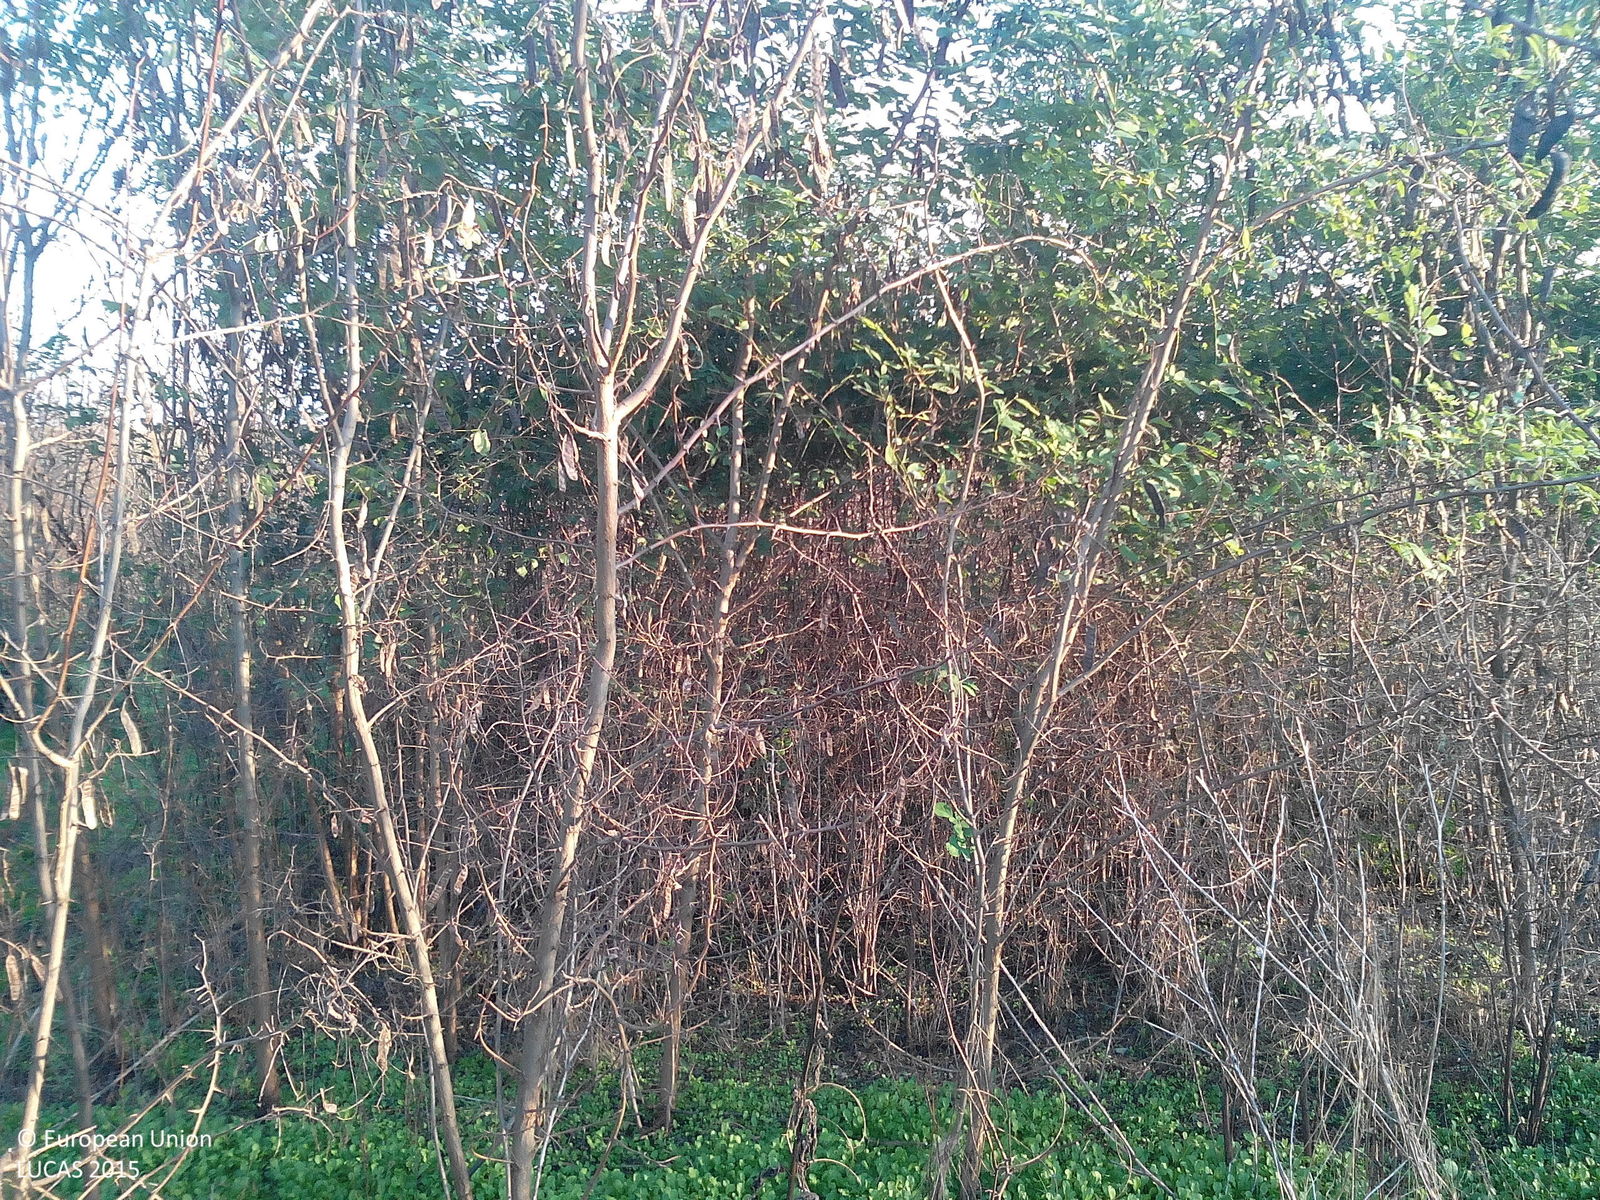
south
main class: Woodland
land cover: Broadleaved woodland
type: thermophilous deciduous forest
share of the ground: 25 - 50 %
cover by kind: herbaceous plants 50 %, broadleaved forest trees 40 %, shrubs 10 %
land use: Semi-natural and natural areas not in use
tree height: < 5 m
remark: Fire break
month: October
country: BG
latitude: 43.5000
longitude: 23.6387
